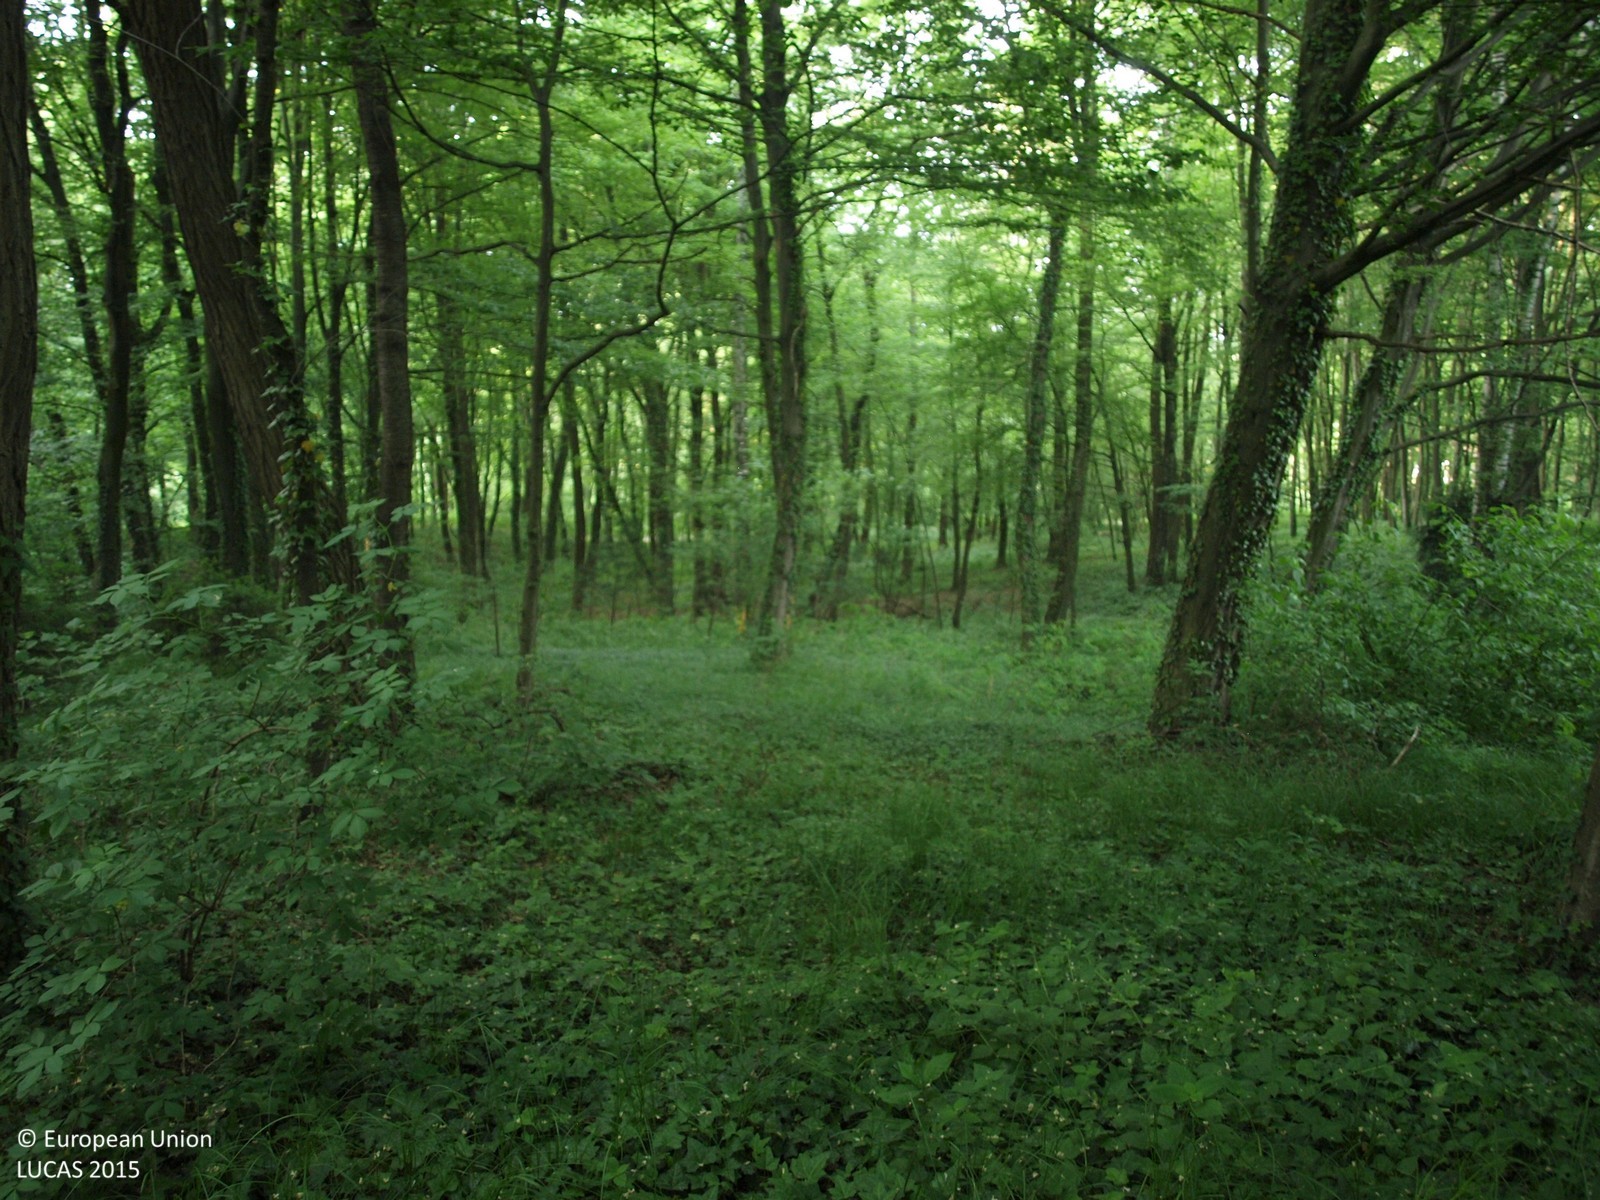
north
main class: Woodland
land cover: Broadleaved woodland
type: mesophytic deciduous forest
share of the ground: > 75 %
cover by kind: broadleaved forest trees 95 %, herbaceous plants 5 %
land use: Forestry
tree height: > 5 m
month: May
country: HR
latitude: 46.2623
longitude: 16.1881
